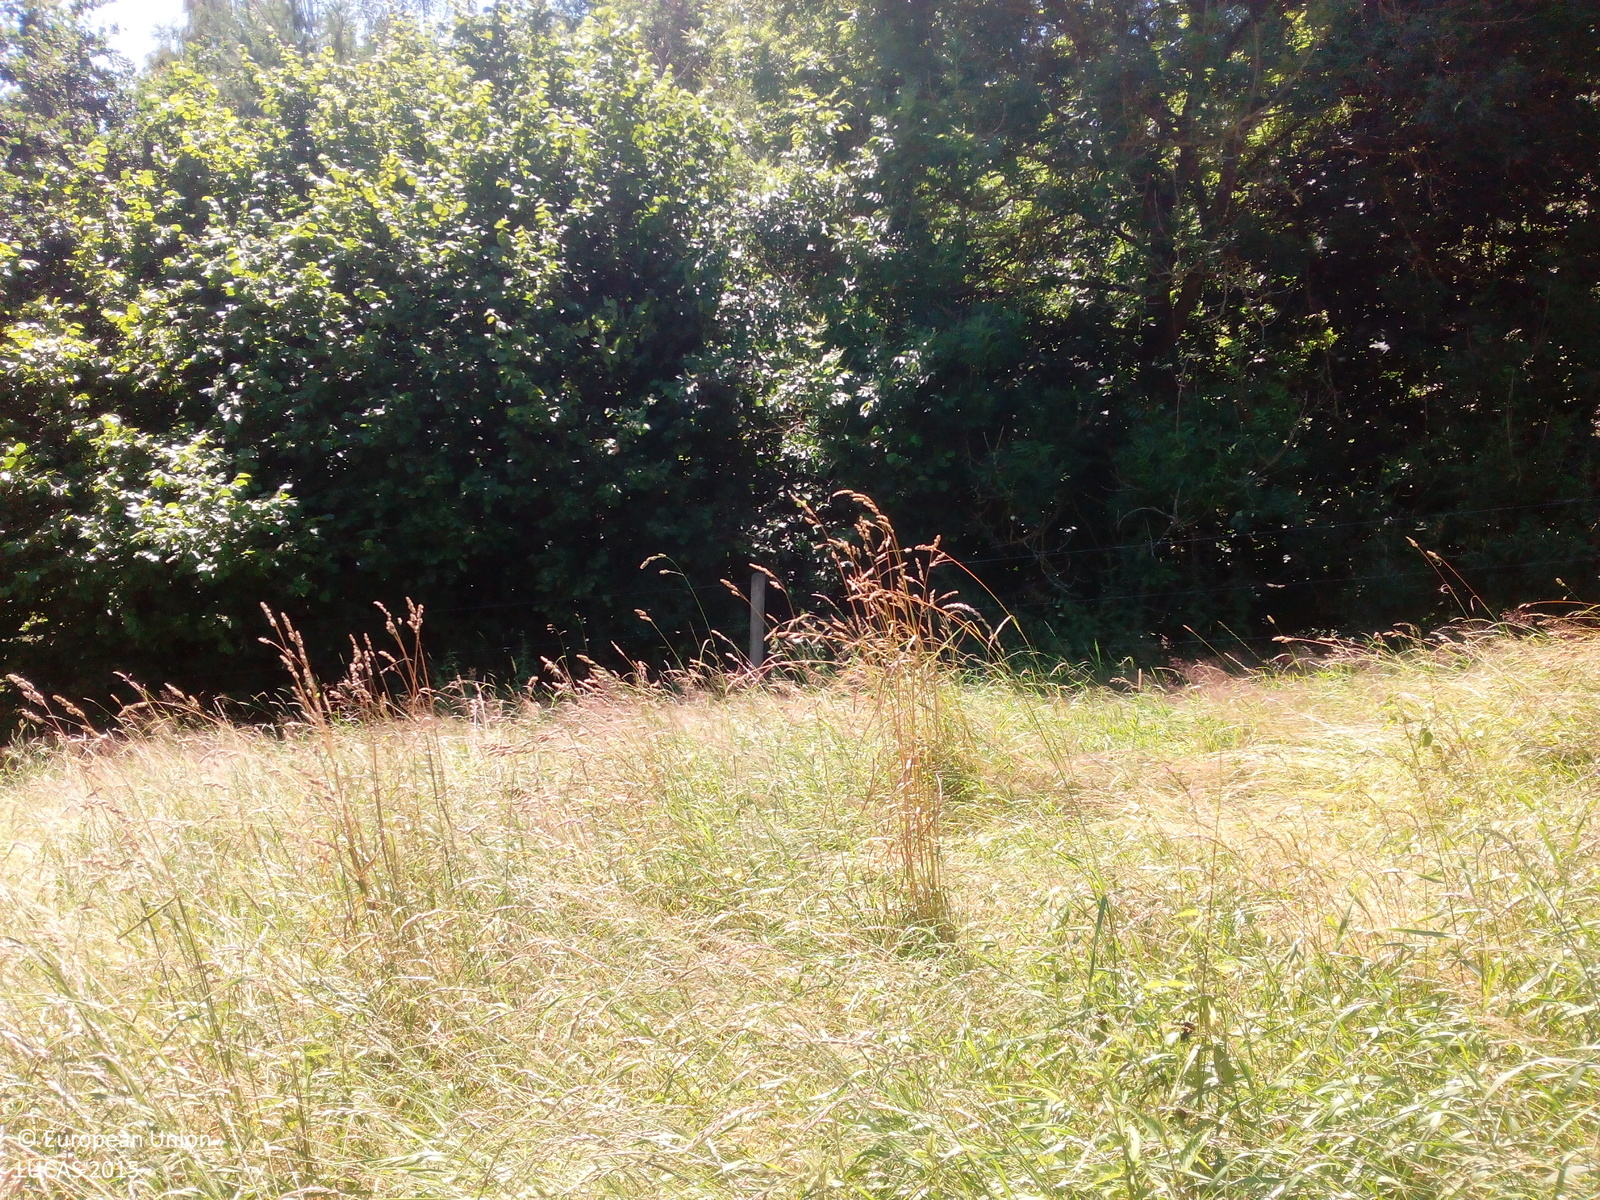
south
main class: Grassland
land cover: Grassland without tree/shrub cover
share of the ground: > 75 %
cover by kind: herbaceous plants 100 %
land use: Agriculture (excluding fallow land and kitchen gardens)
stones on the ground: < 10 %
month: July
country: DE
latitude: 49.7671
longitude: 12.2071
